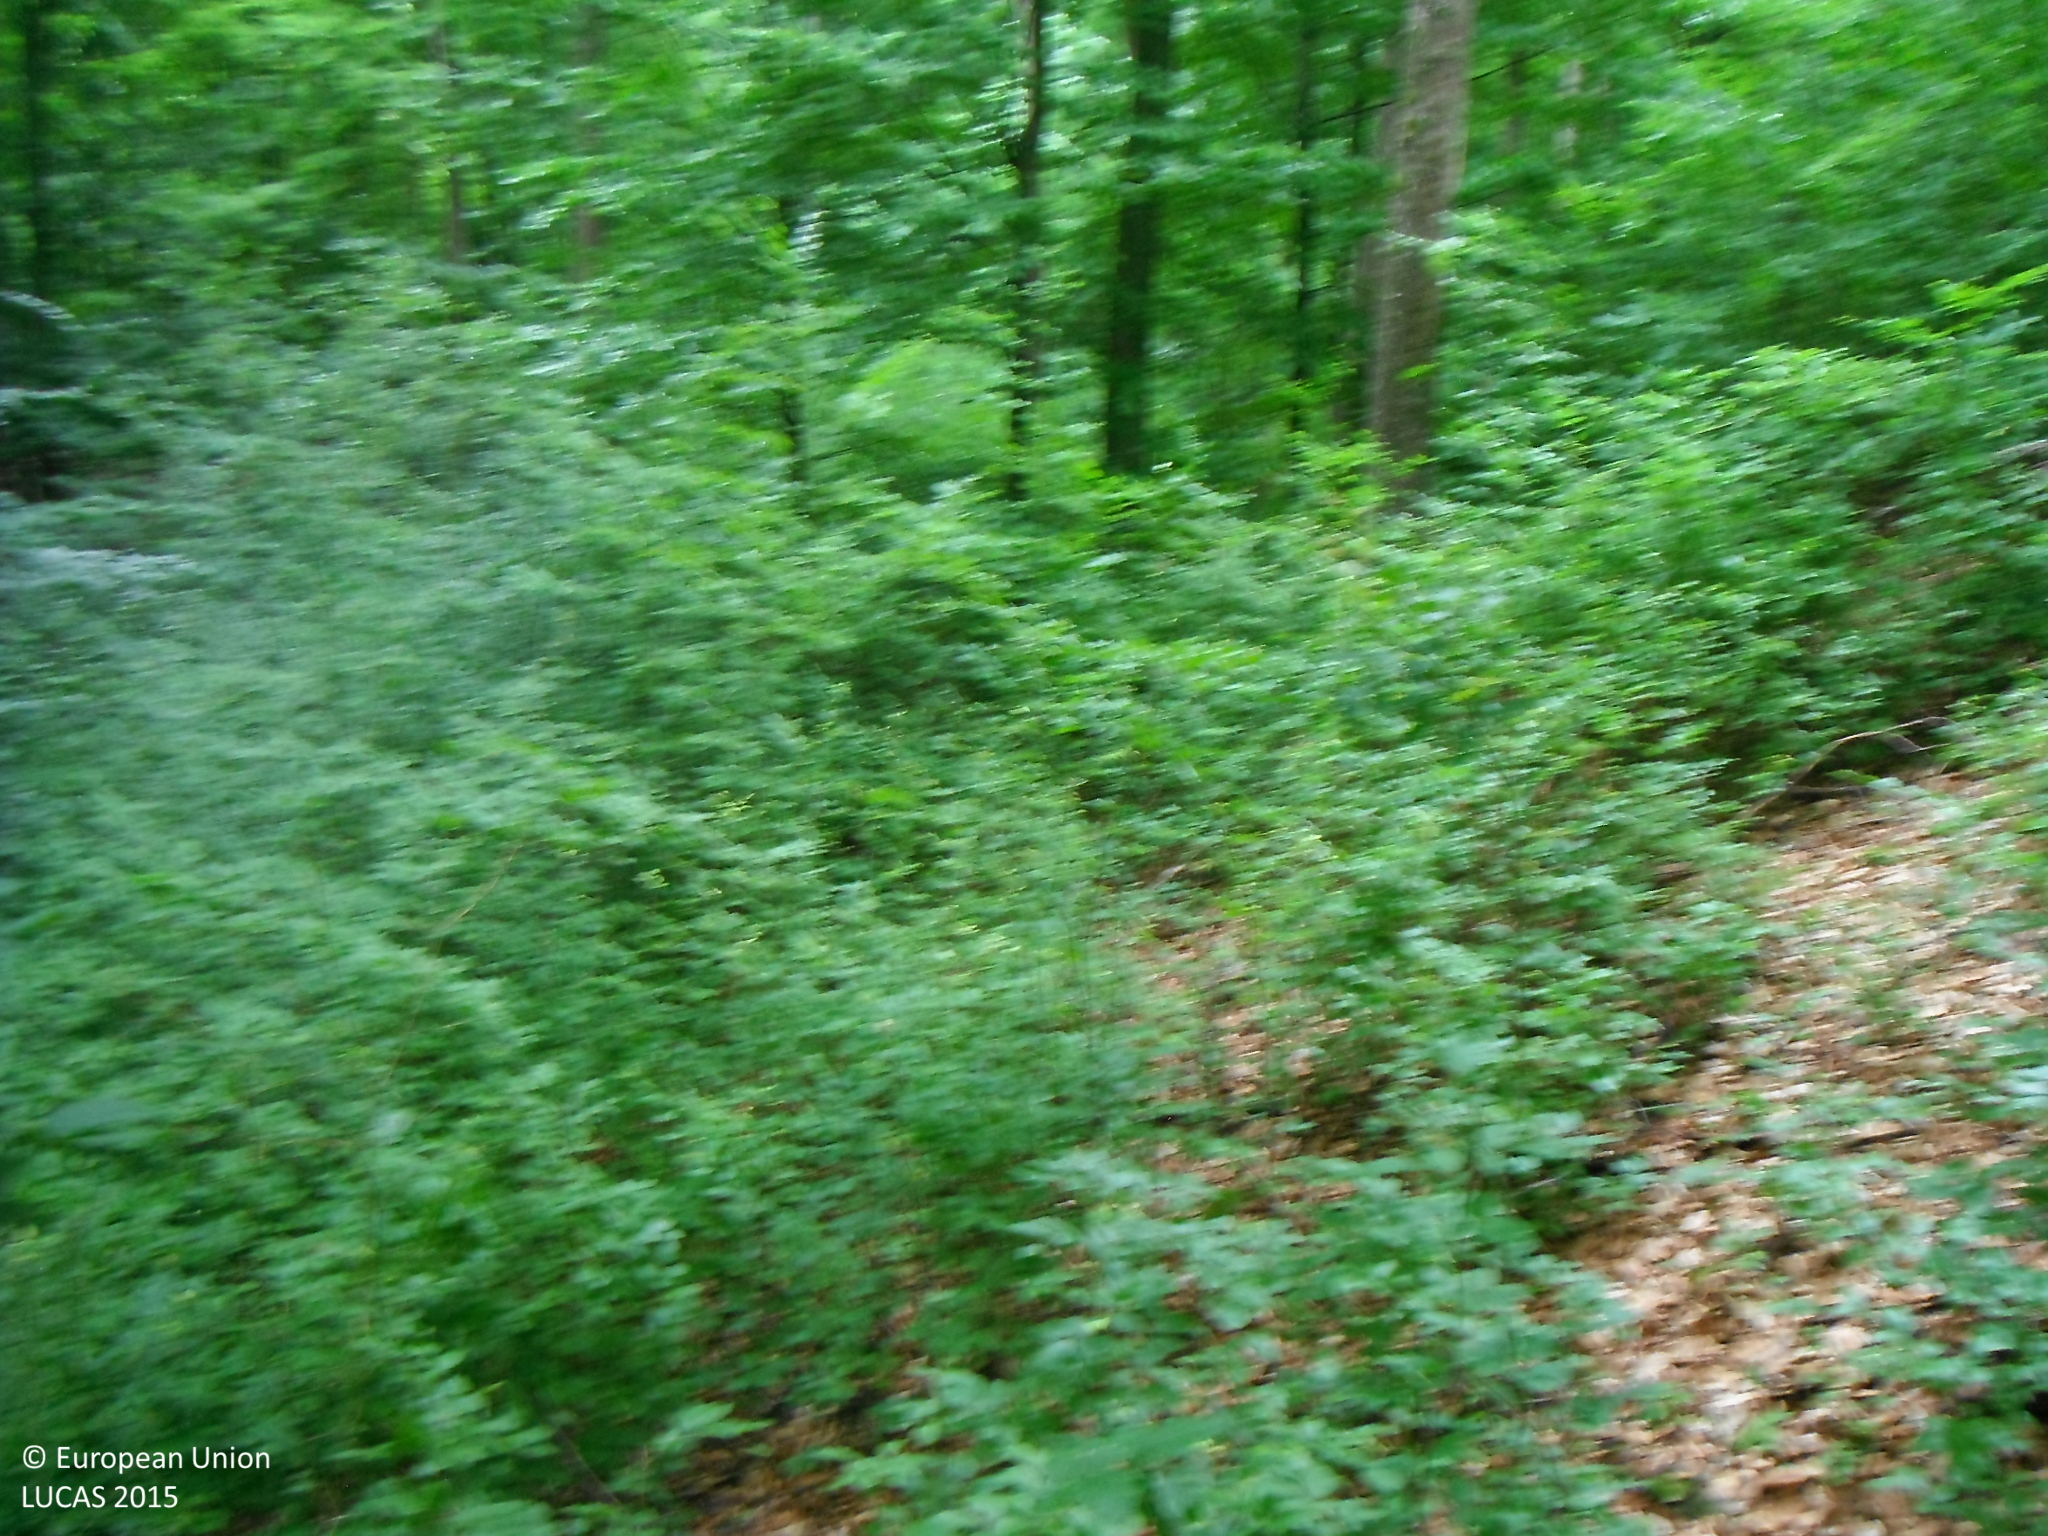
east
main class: Woodland
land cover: Broadleaved woodland
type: beech forest
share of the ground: > 75 %
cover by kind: broadleaved forest trees 100 %
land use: Forestry
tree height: > 5 m
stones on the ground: 25 - 50 %
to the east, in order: Broadleaved woodland
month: June
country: SK
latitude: 48.5056
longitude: 20.0598
